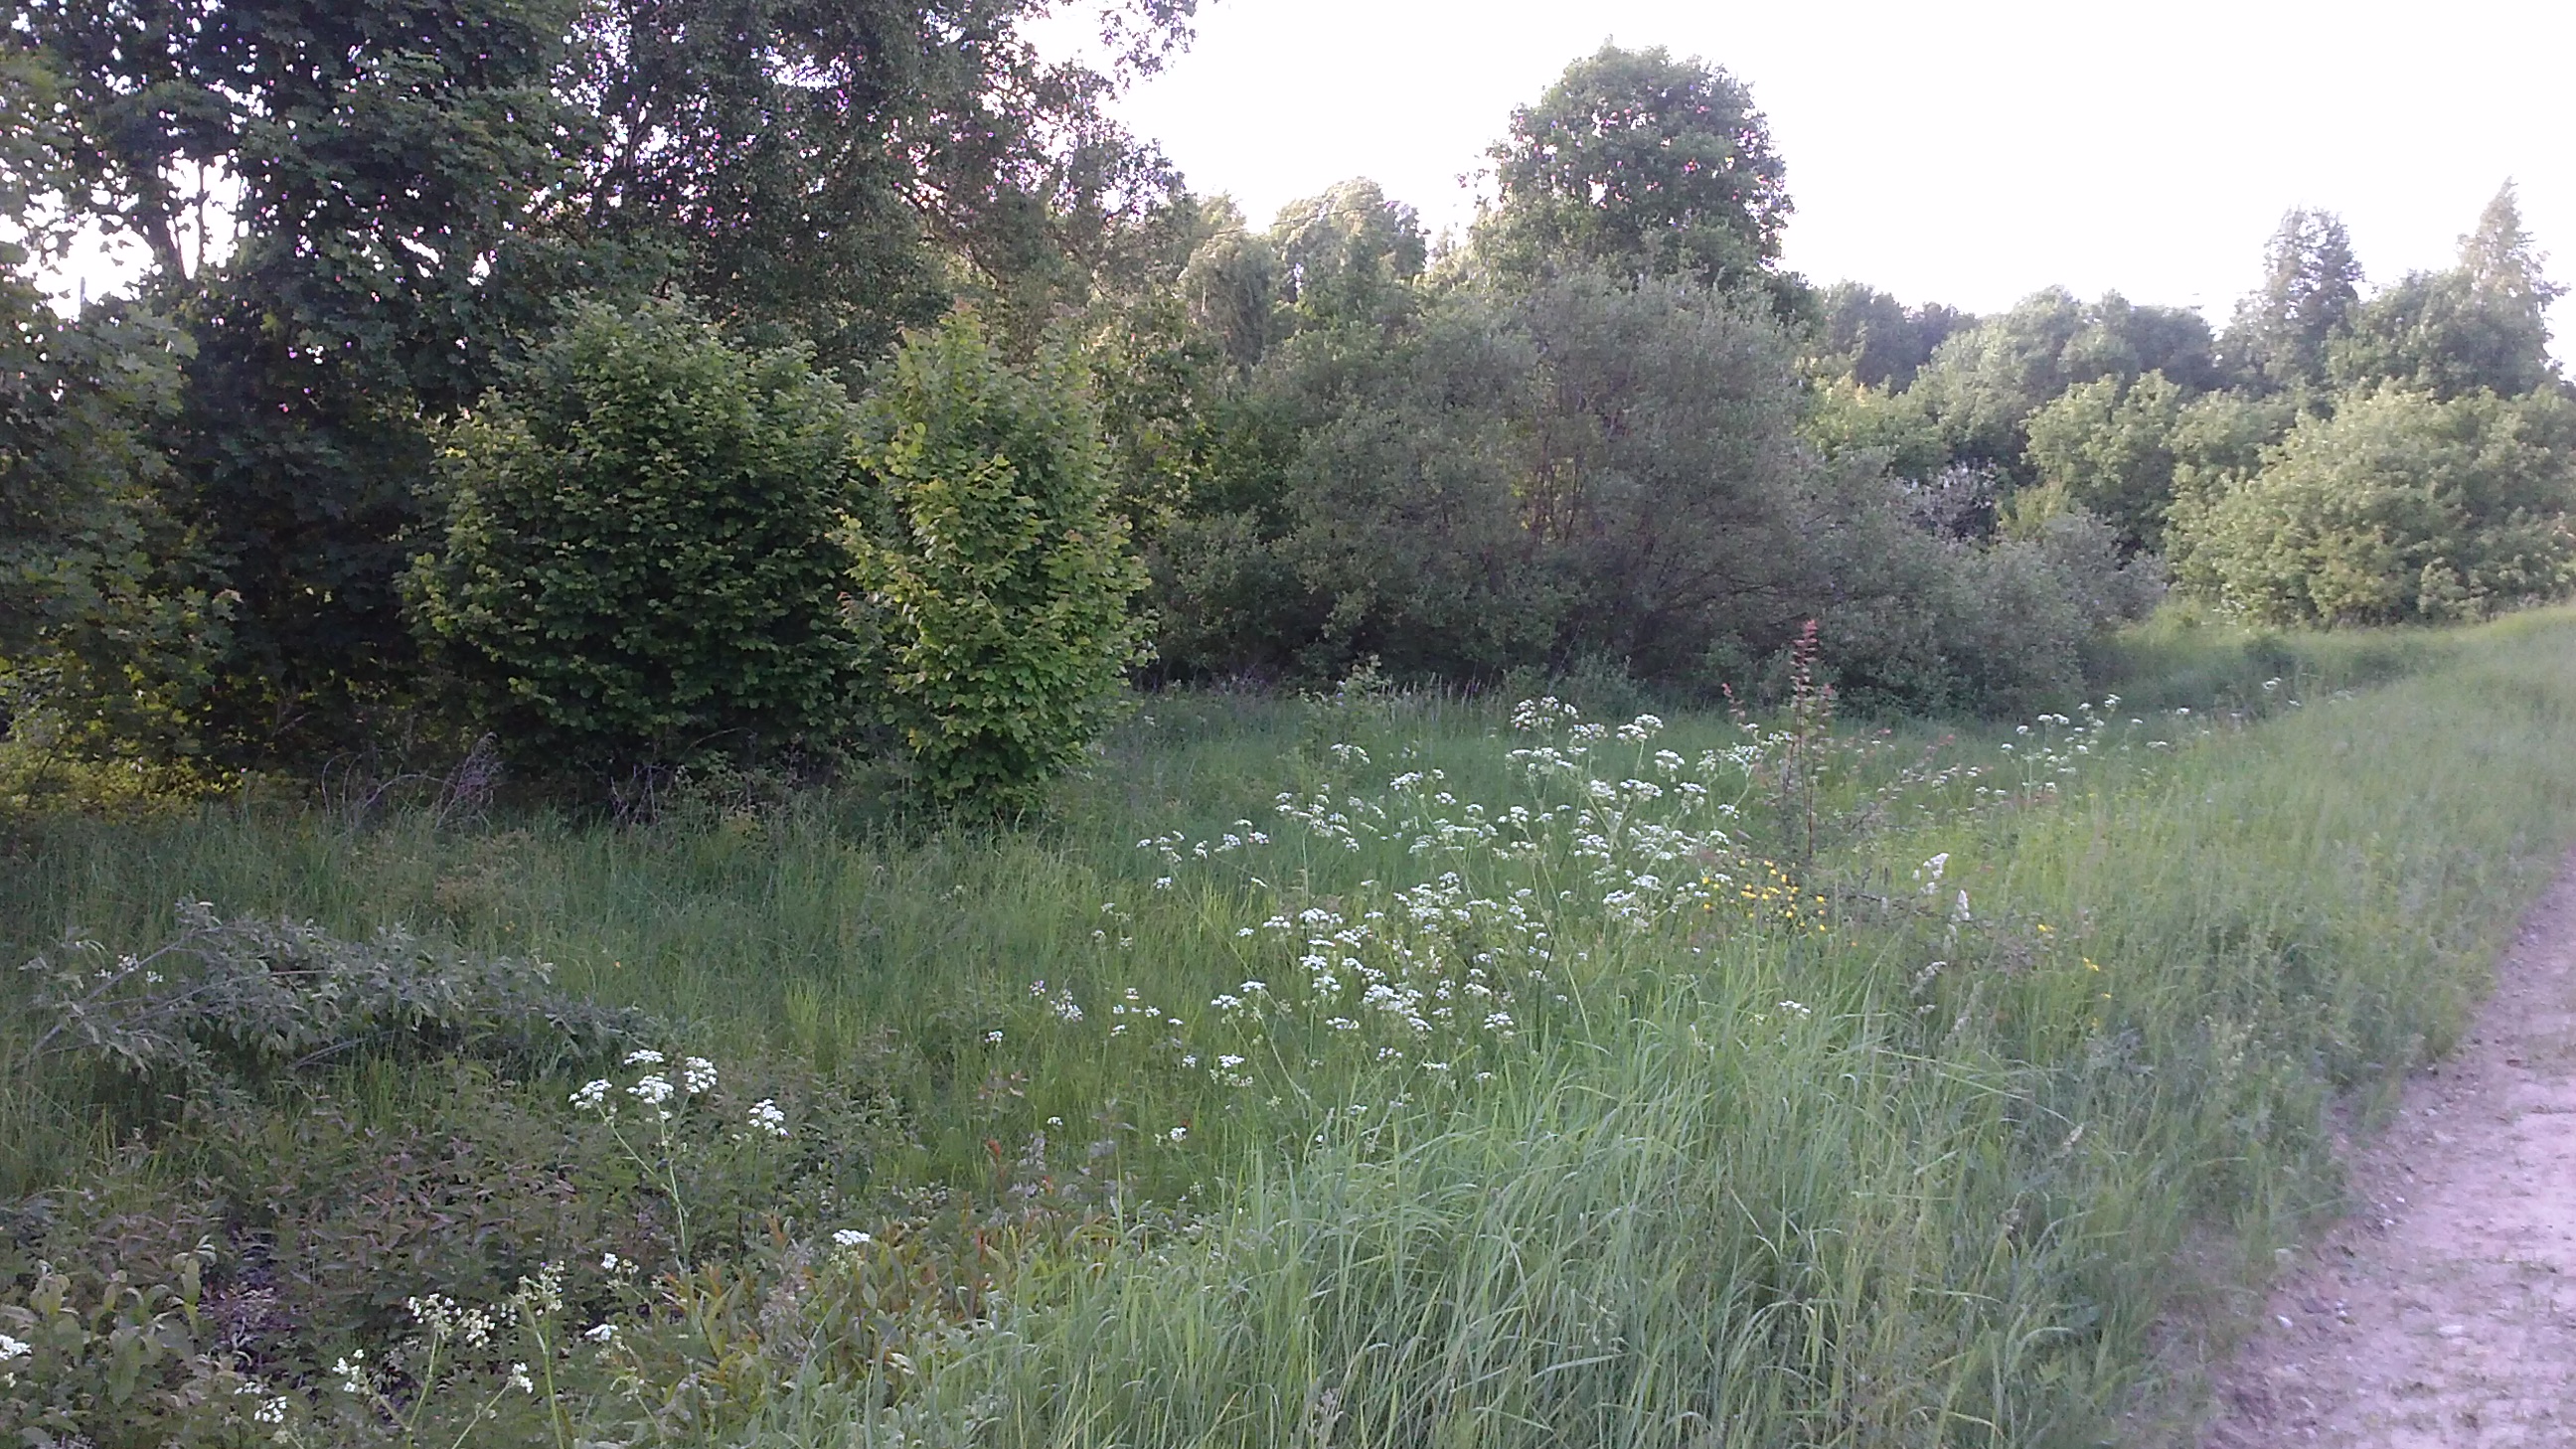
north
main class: Woodland
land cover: Broadleaved woodland
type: non-riverine alder, birch or aspen forest
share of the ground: > 75 %
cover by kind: broadleaved forest trees 100 %
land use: Forestry
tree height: > 5 m
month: June
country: LV
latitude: 56.4691
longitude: 28.0034
